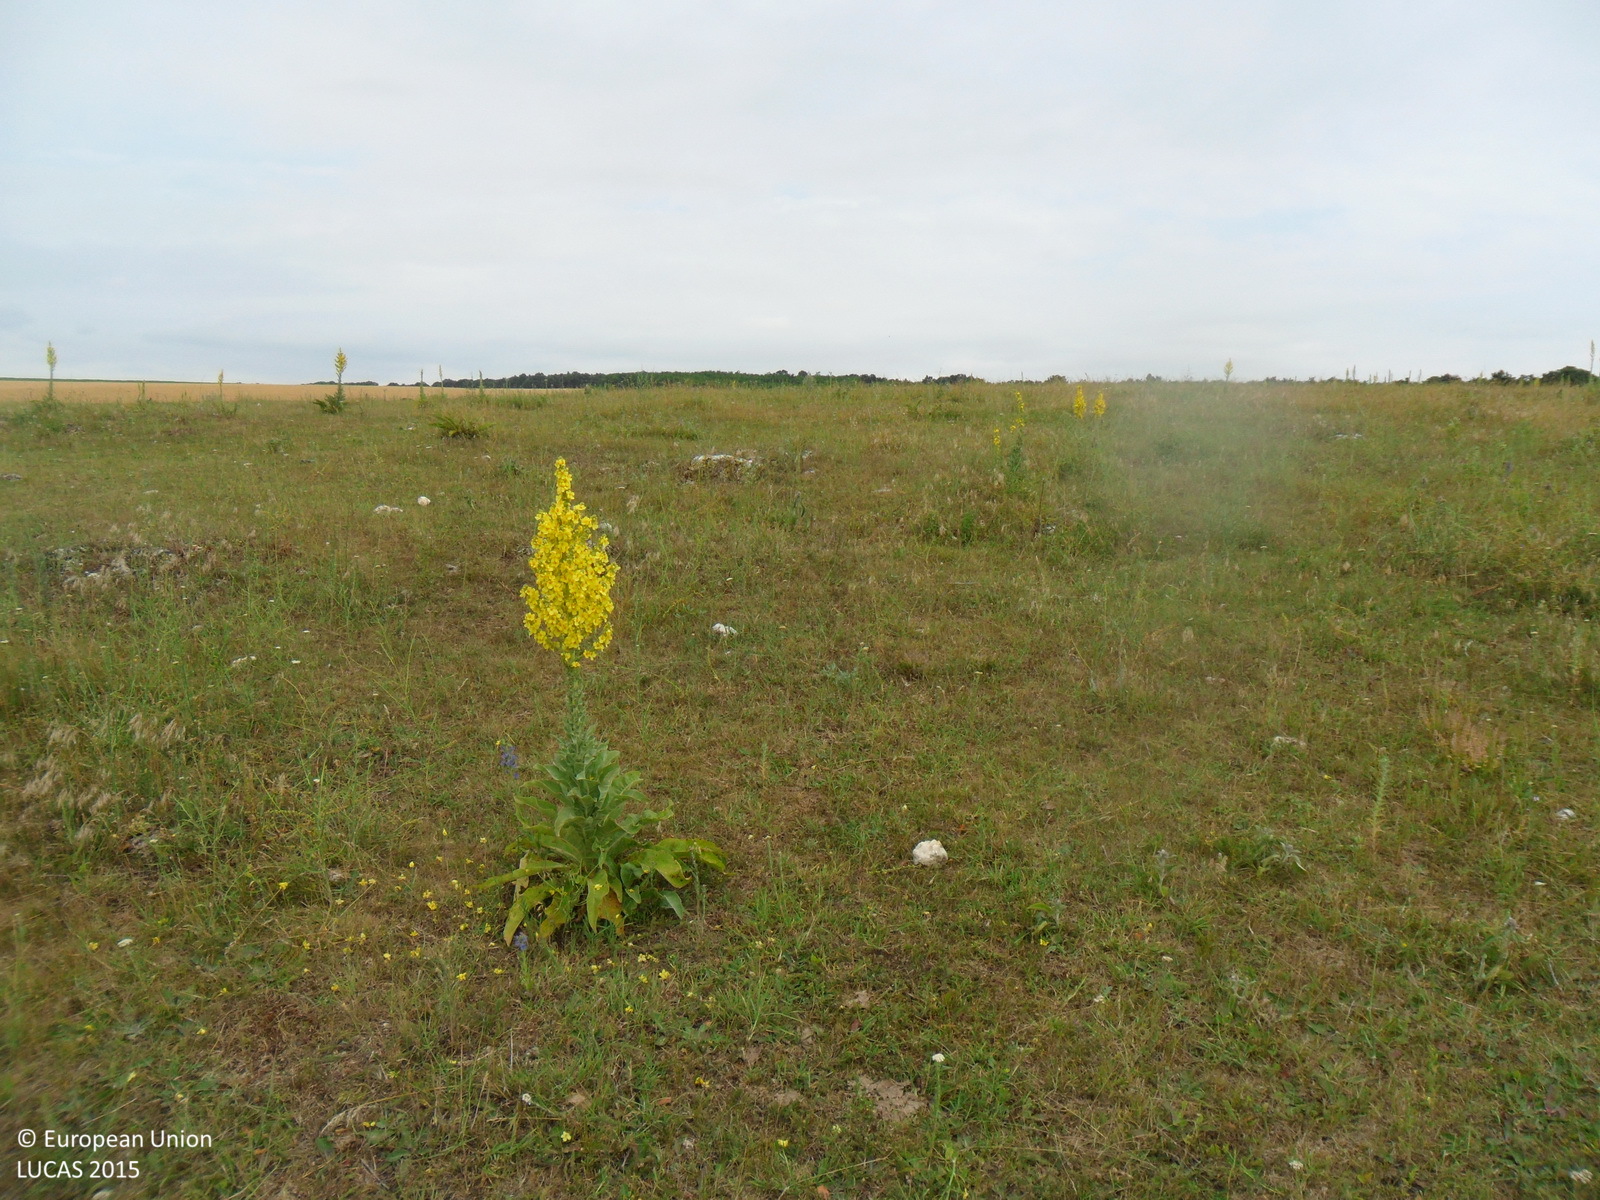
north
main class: Grassland
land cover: Grassland without tree/shrub cover
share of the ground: > 75 %
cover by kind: herbaceous plants 100 %
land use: Agriculture (excluding fallow land and kitchen gardens)
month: June
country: BG
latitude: 43.7373
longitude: 26.7132
